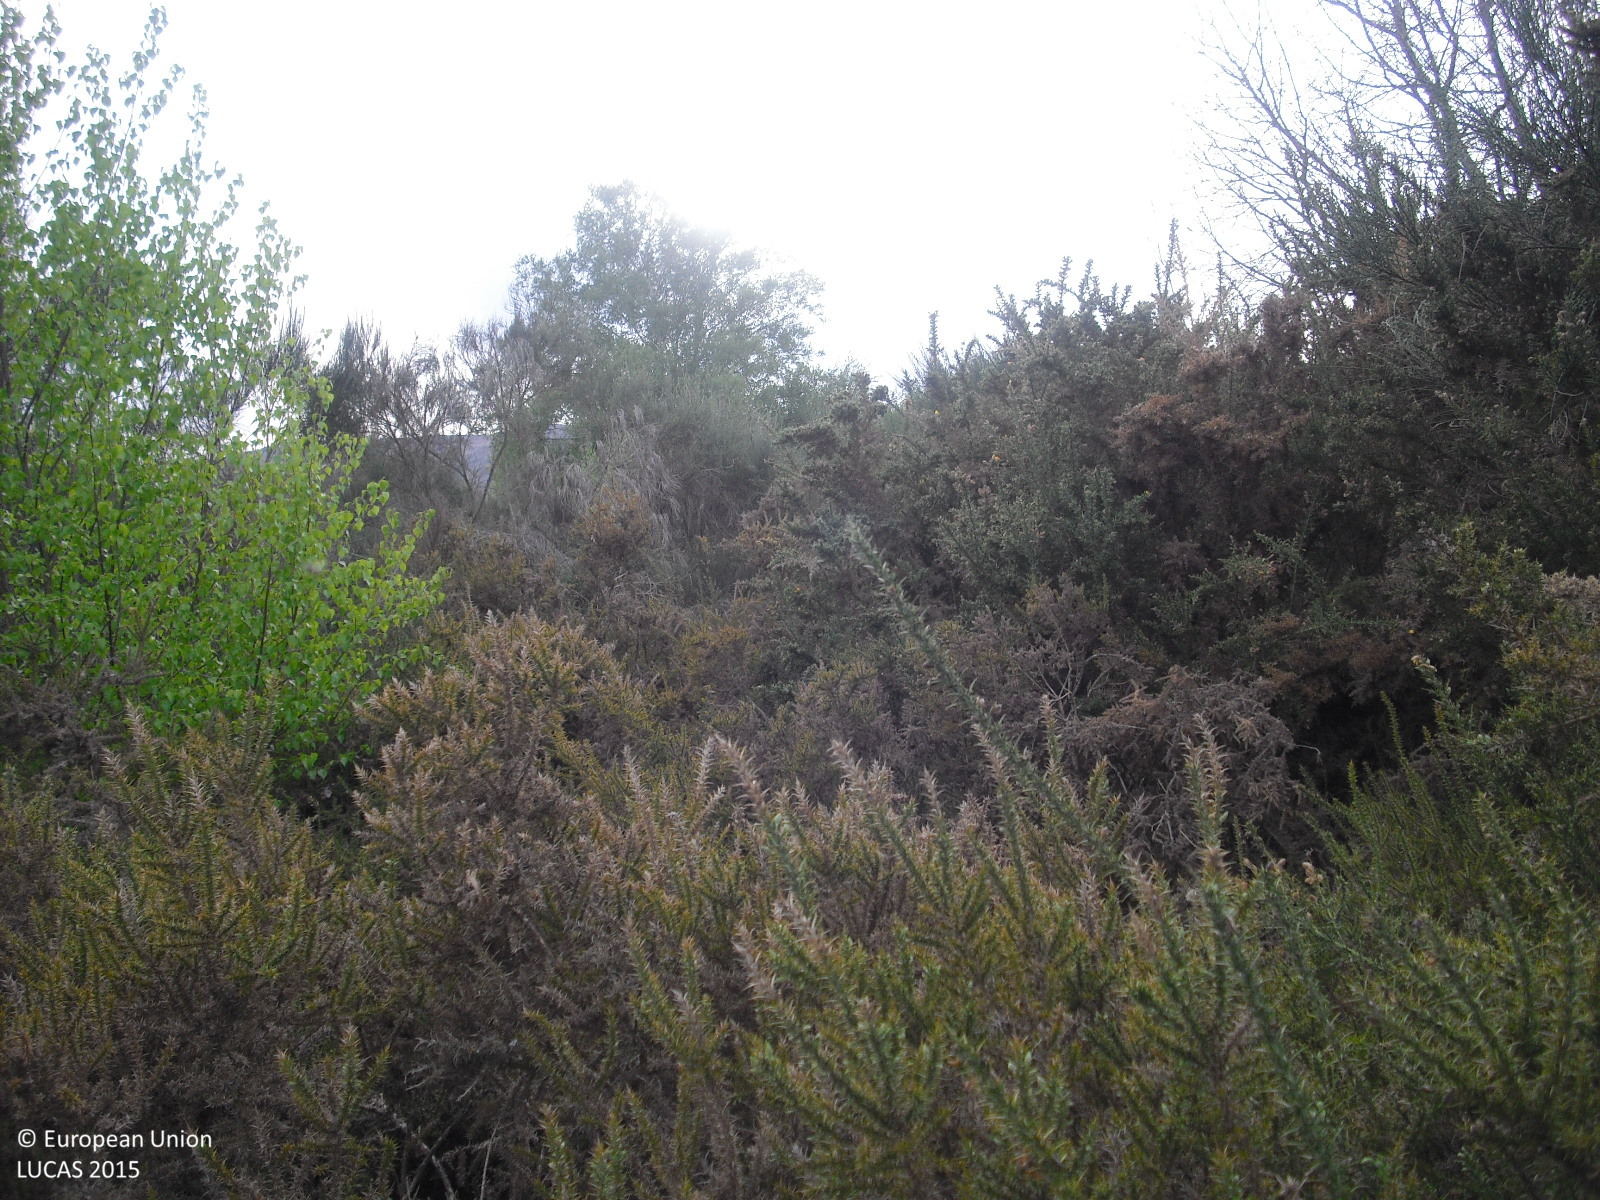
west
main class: Shrubland
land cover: Shrubland with sparse tree cover
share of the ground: > 75 %
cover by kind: shrubs 95 %, broadleaved forest trees 5 %
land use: Abandoned areas
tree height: < 5 m
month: April
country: ES
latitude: 41.9006
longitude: -7.6520
